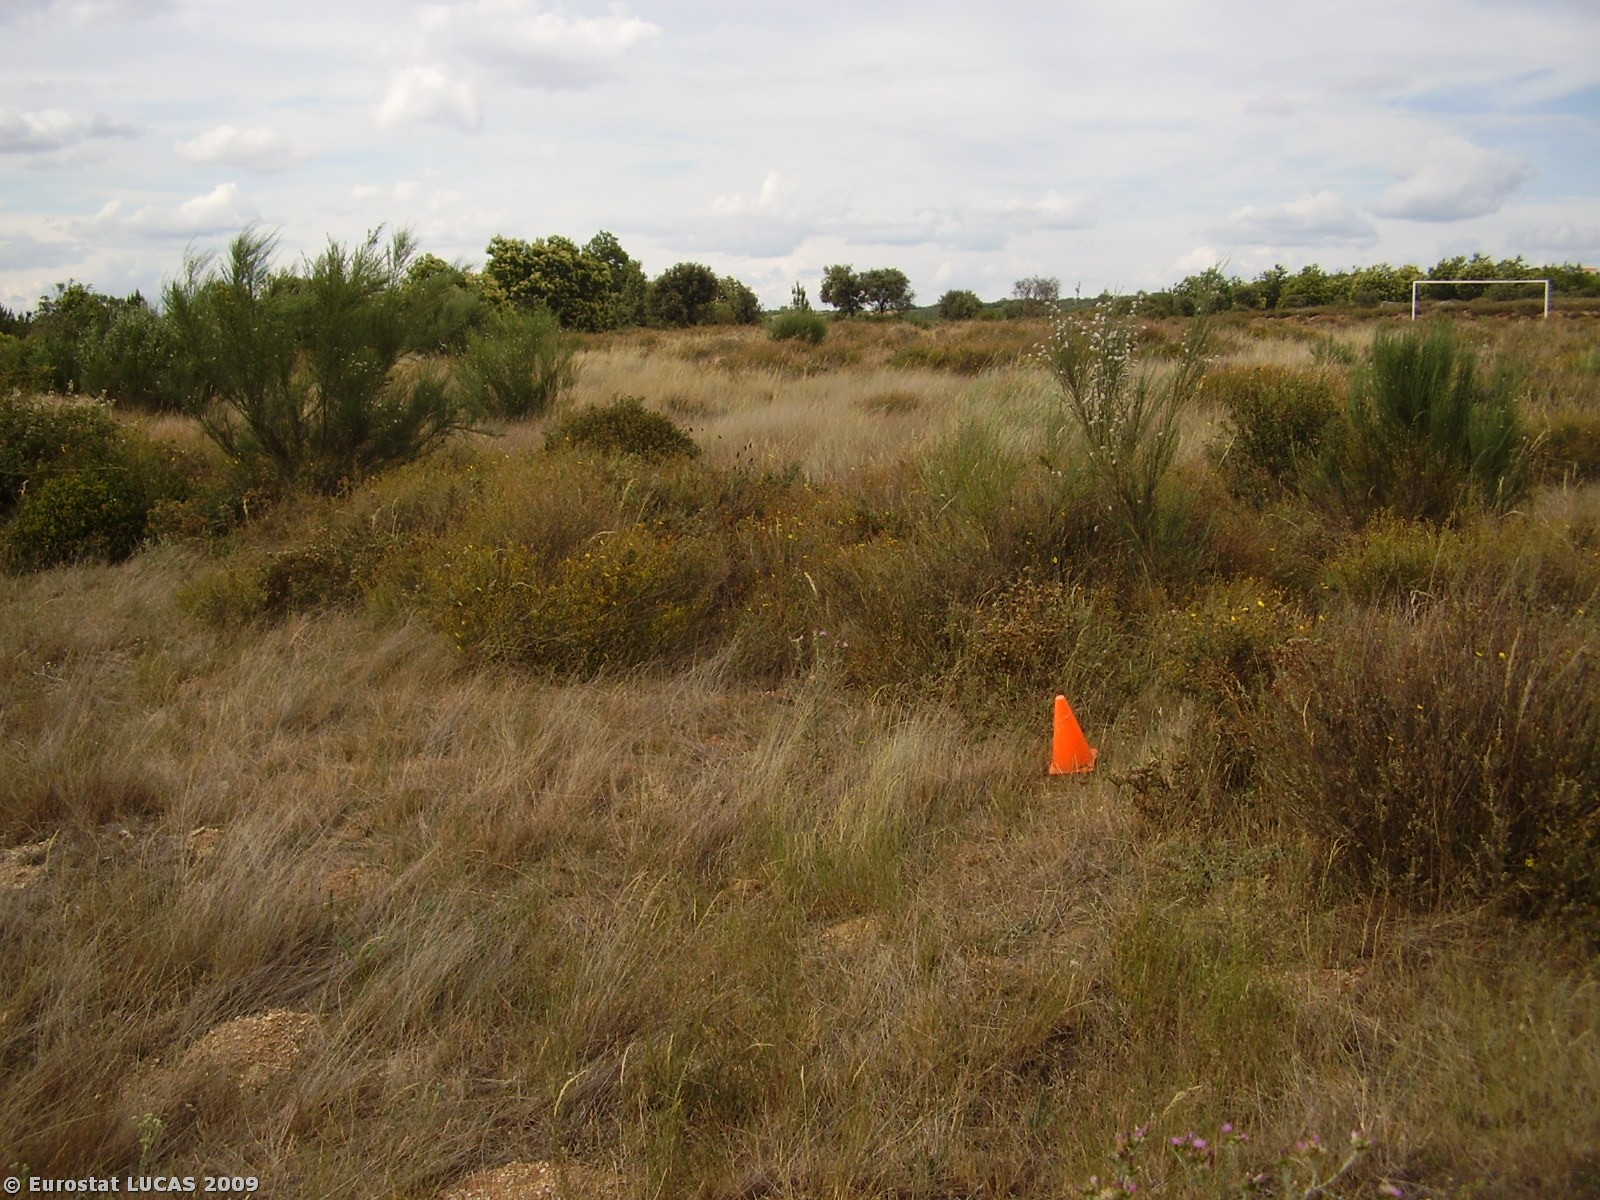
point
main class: Grassland
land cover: Spontaneously vegetated surfaces
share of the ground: > 75 %
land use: Unused
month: June
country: PT
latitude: 41.6230
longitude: -6.2662
